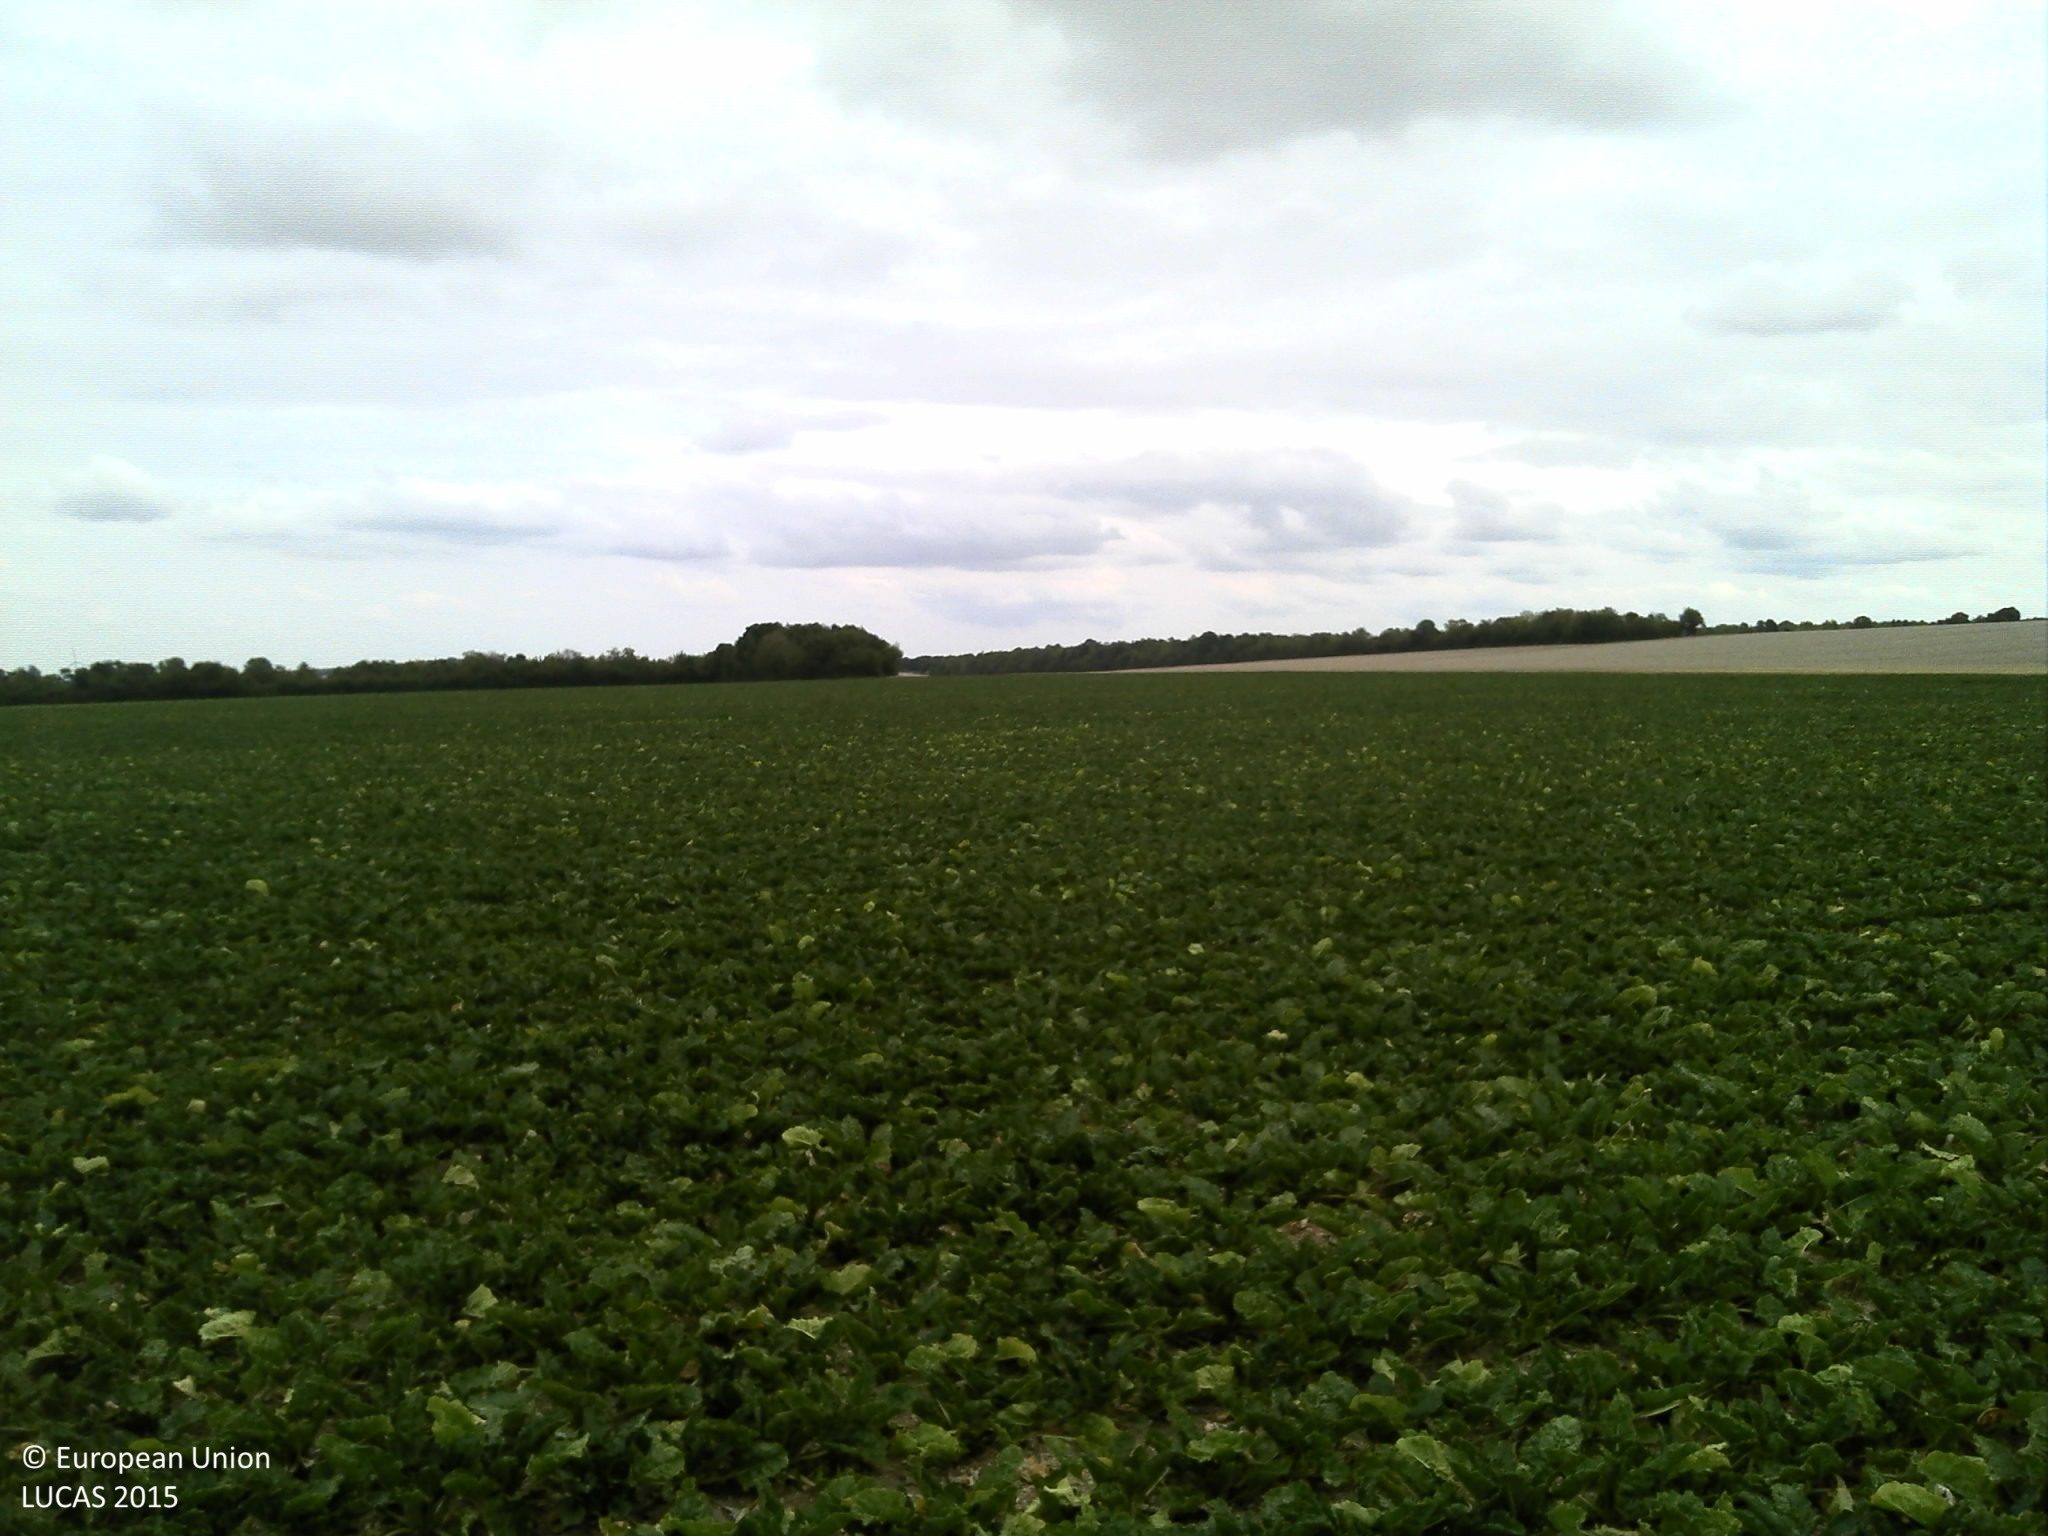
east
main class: Cropland
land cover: Sugar beet
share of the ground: > 75 %
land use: Agriculture (excluding fallow land and kitchen gardens)
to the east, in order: Sugar beet
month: August
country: FR
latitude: 48.4660
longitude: 4.1672
